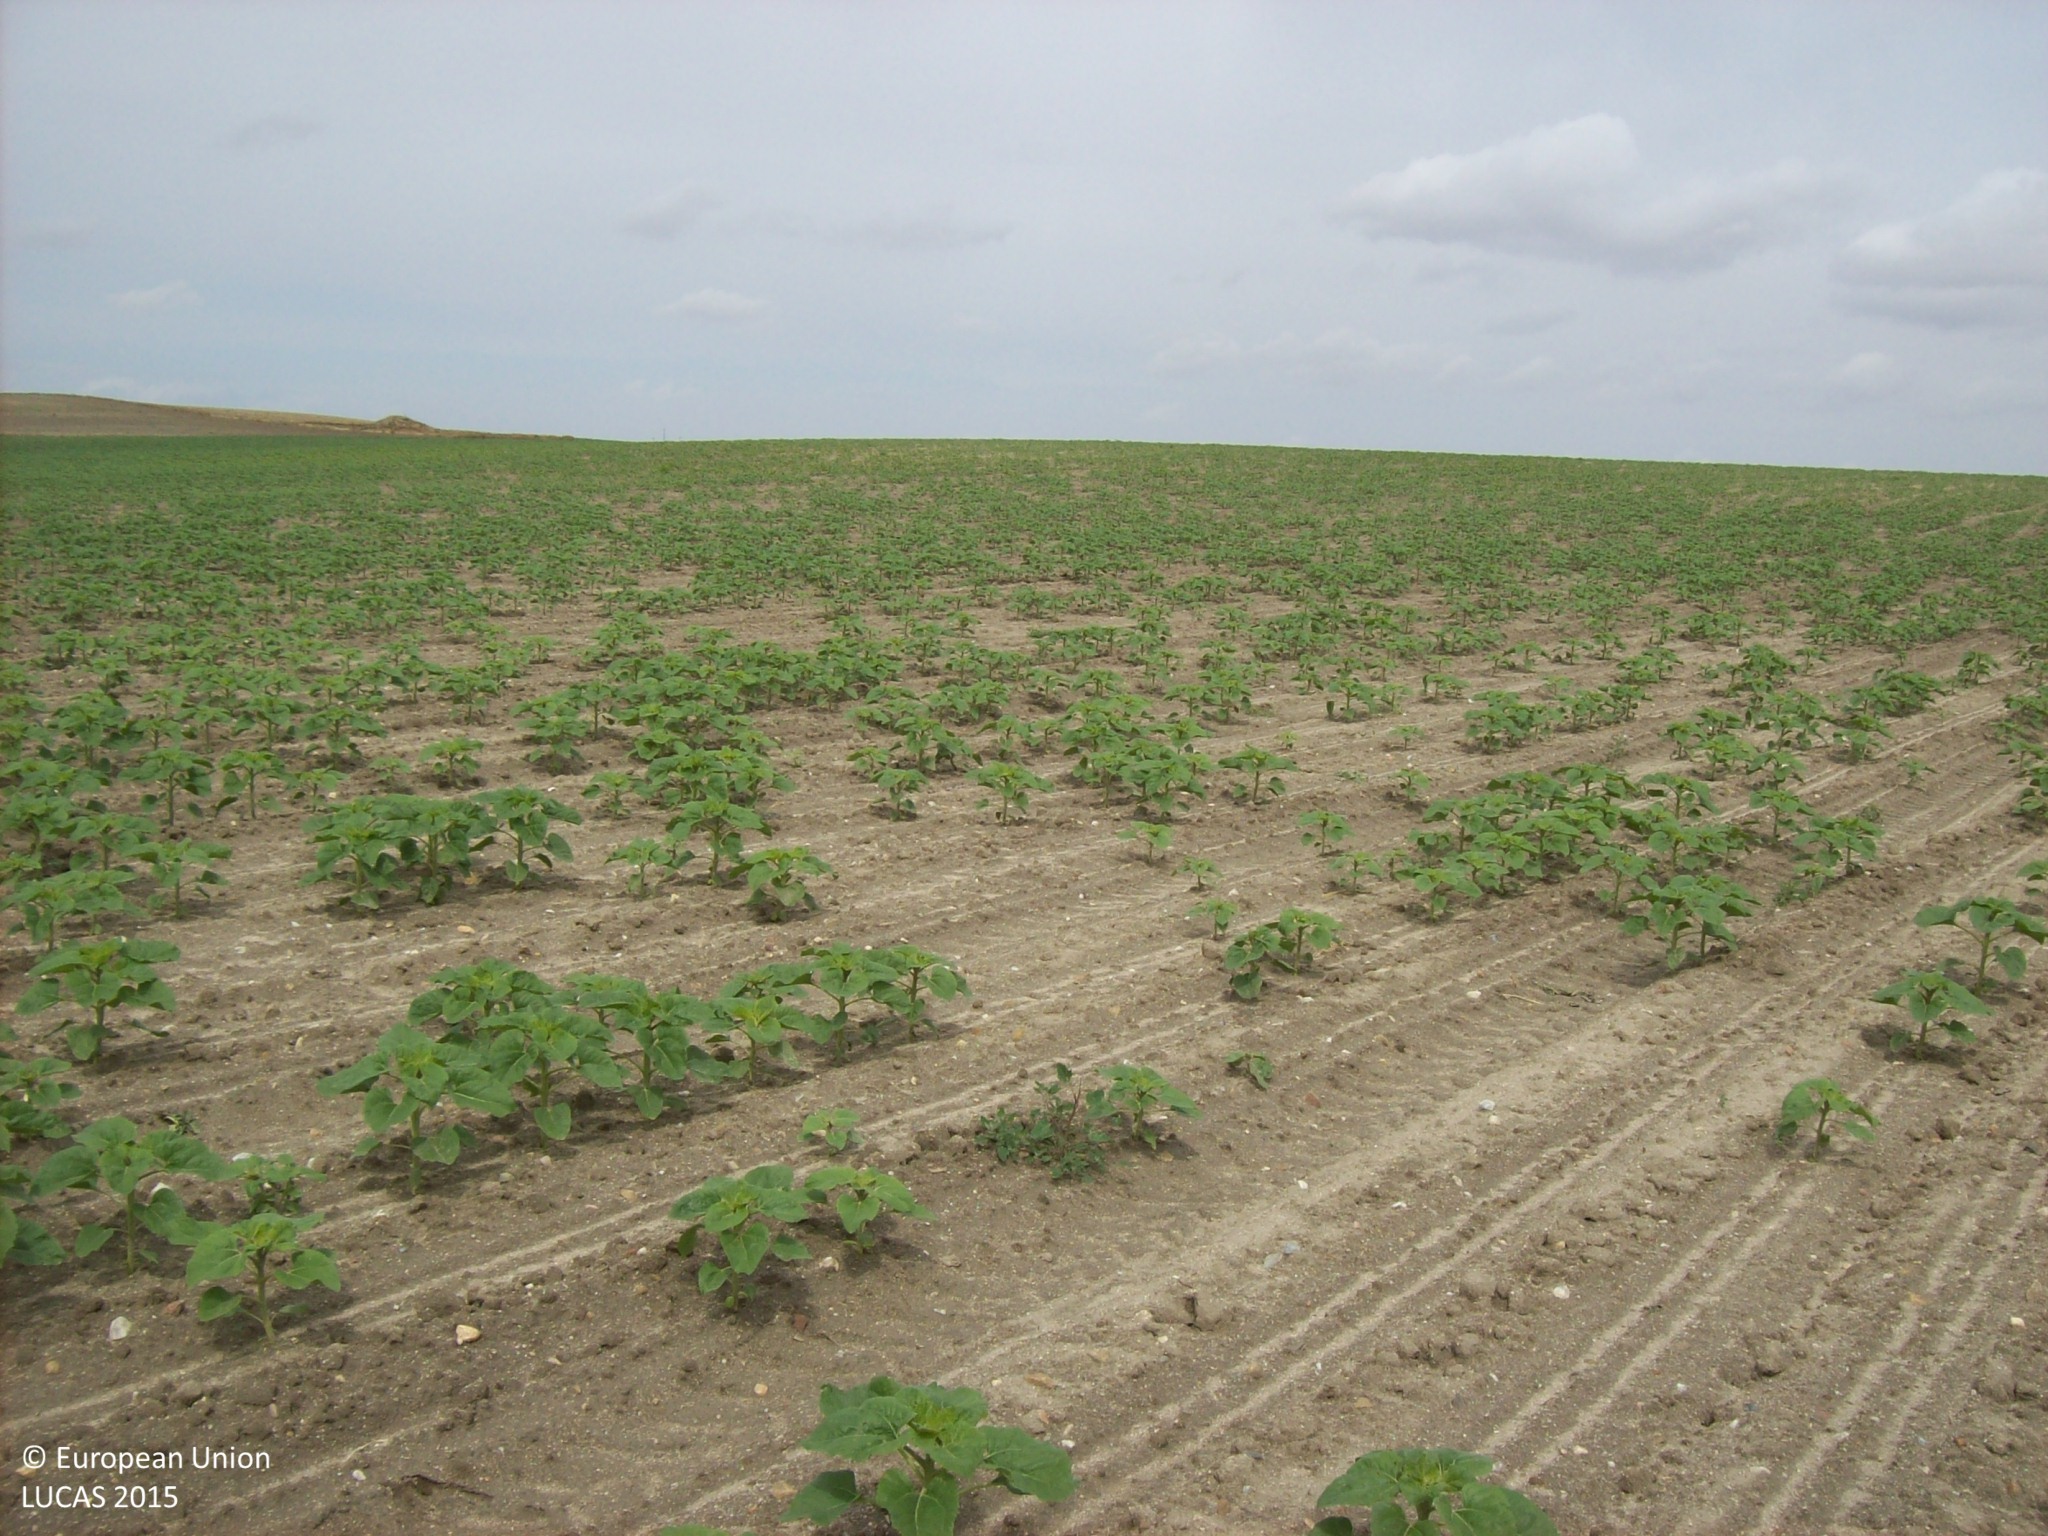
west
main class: Cropland
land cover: Sunflower
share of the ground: 50 - 75 %
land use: Agriculture (excluding fallow land and kitchen gardens)
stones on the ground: < 10 %
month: June
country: ES
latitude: 40.9575
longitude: -5.0232
